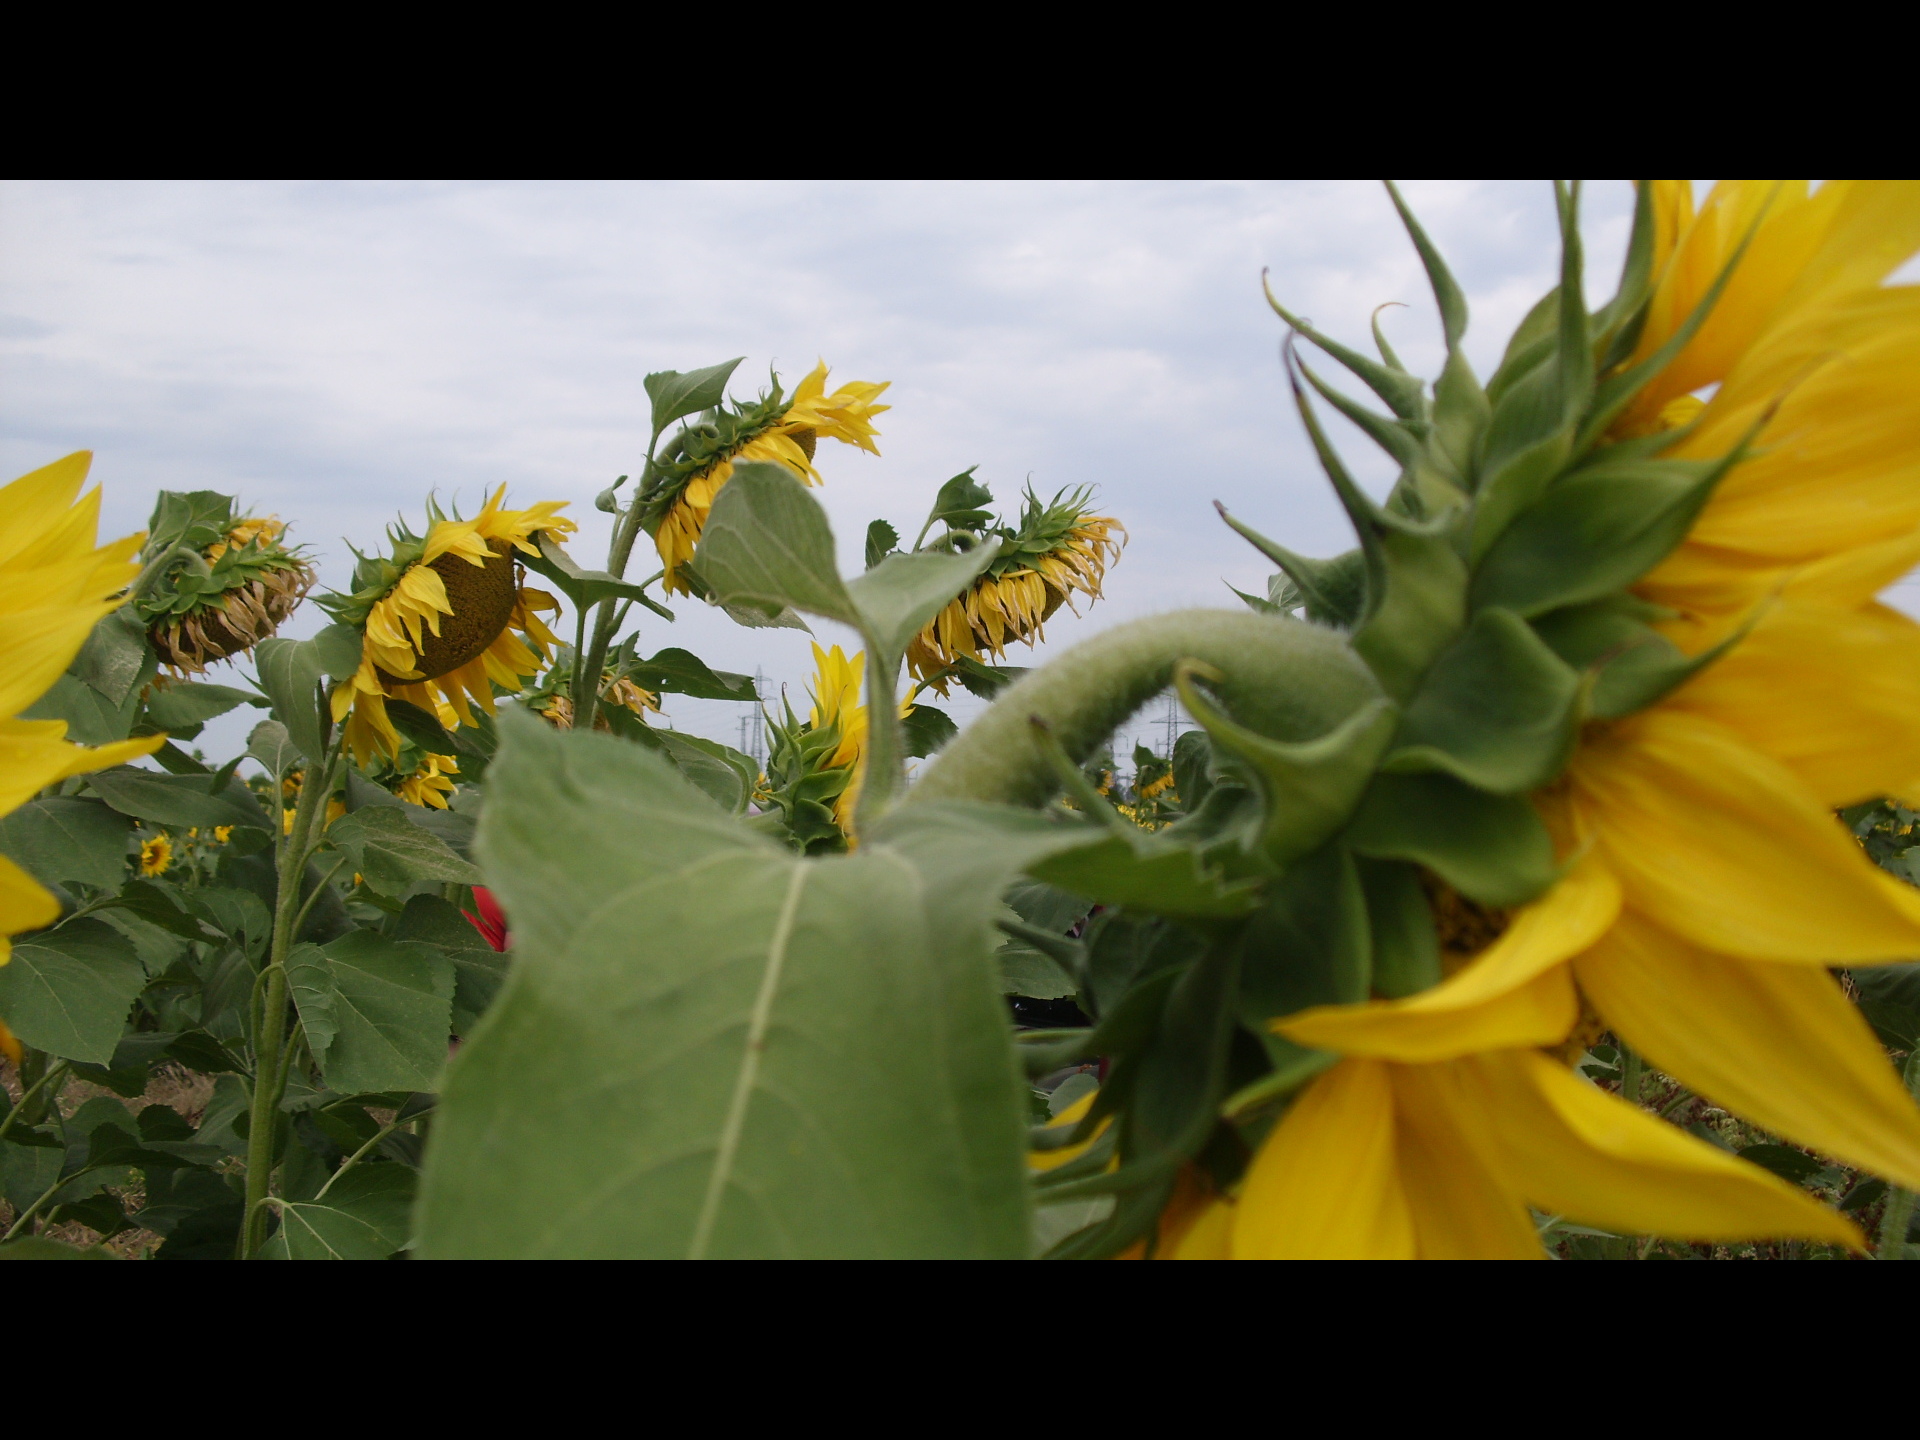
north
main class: Cropland
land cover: Sunflower
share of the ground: > 75 %
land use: Agriculture (excluding fallow land and kitchen gardens)
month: July
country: BG
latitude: 43.9333
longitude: 22.8317
